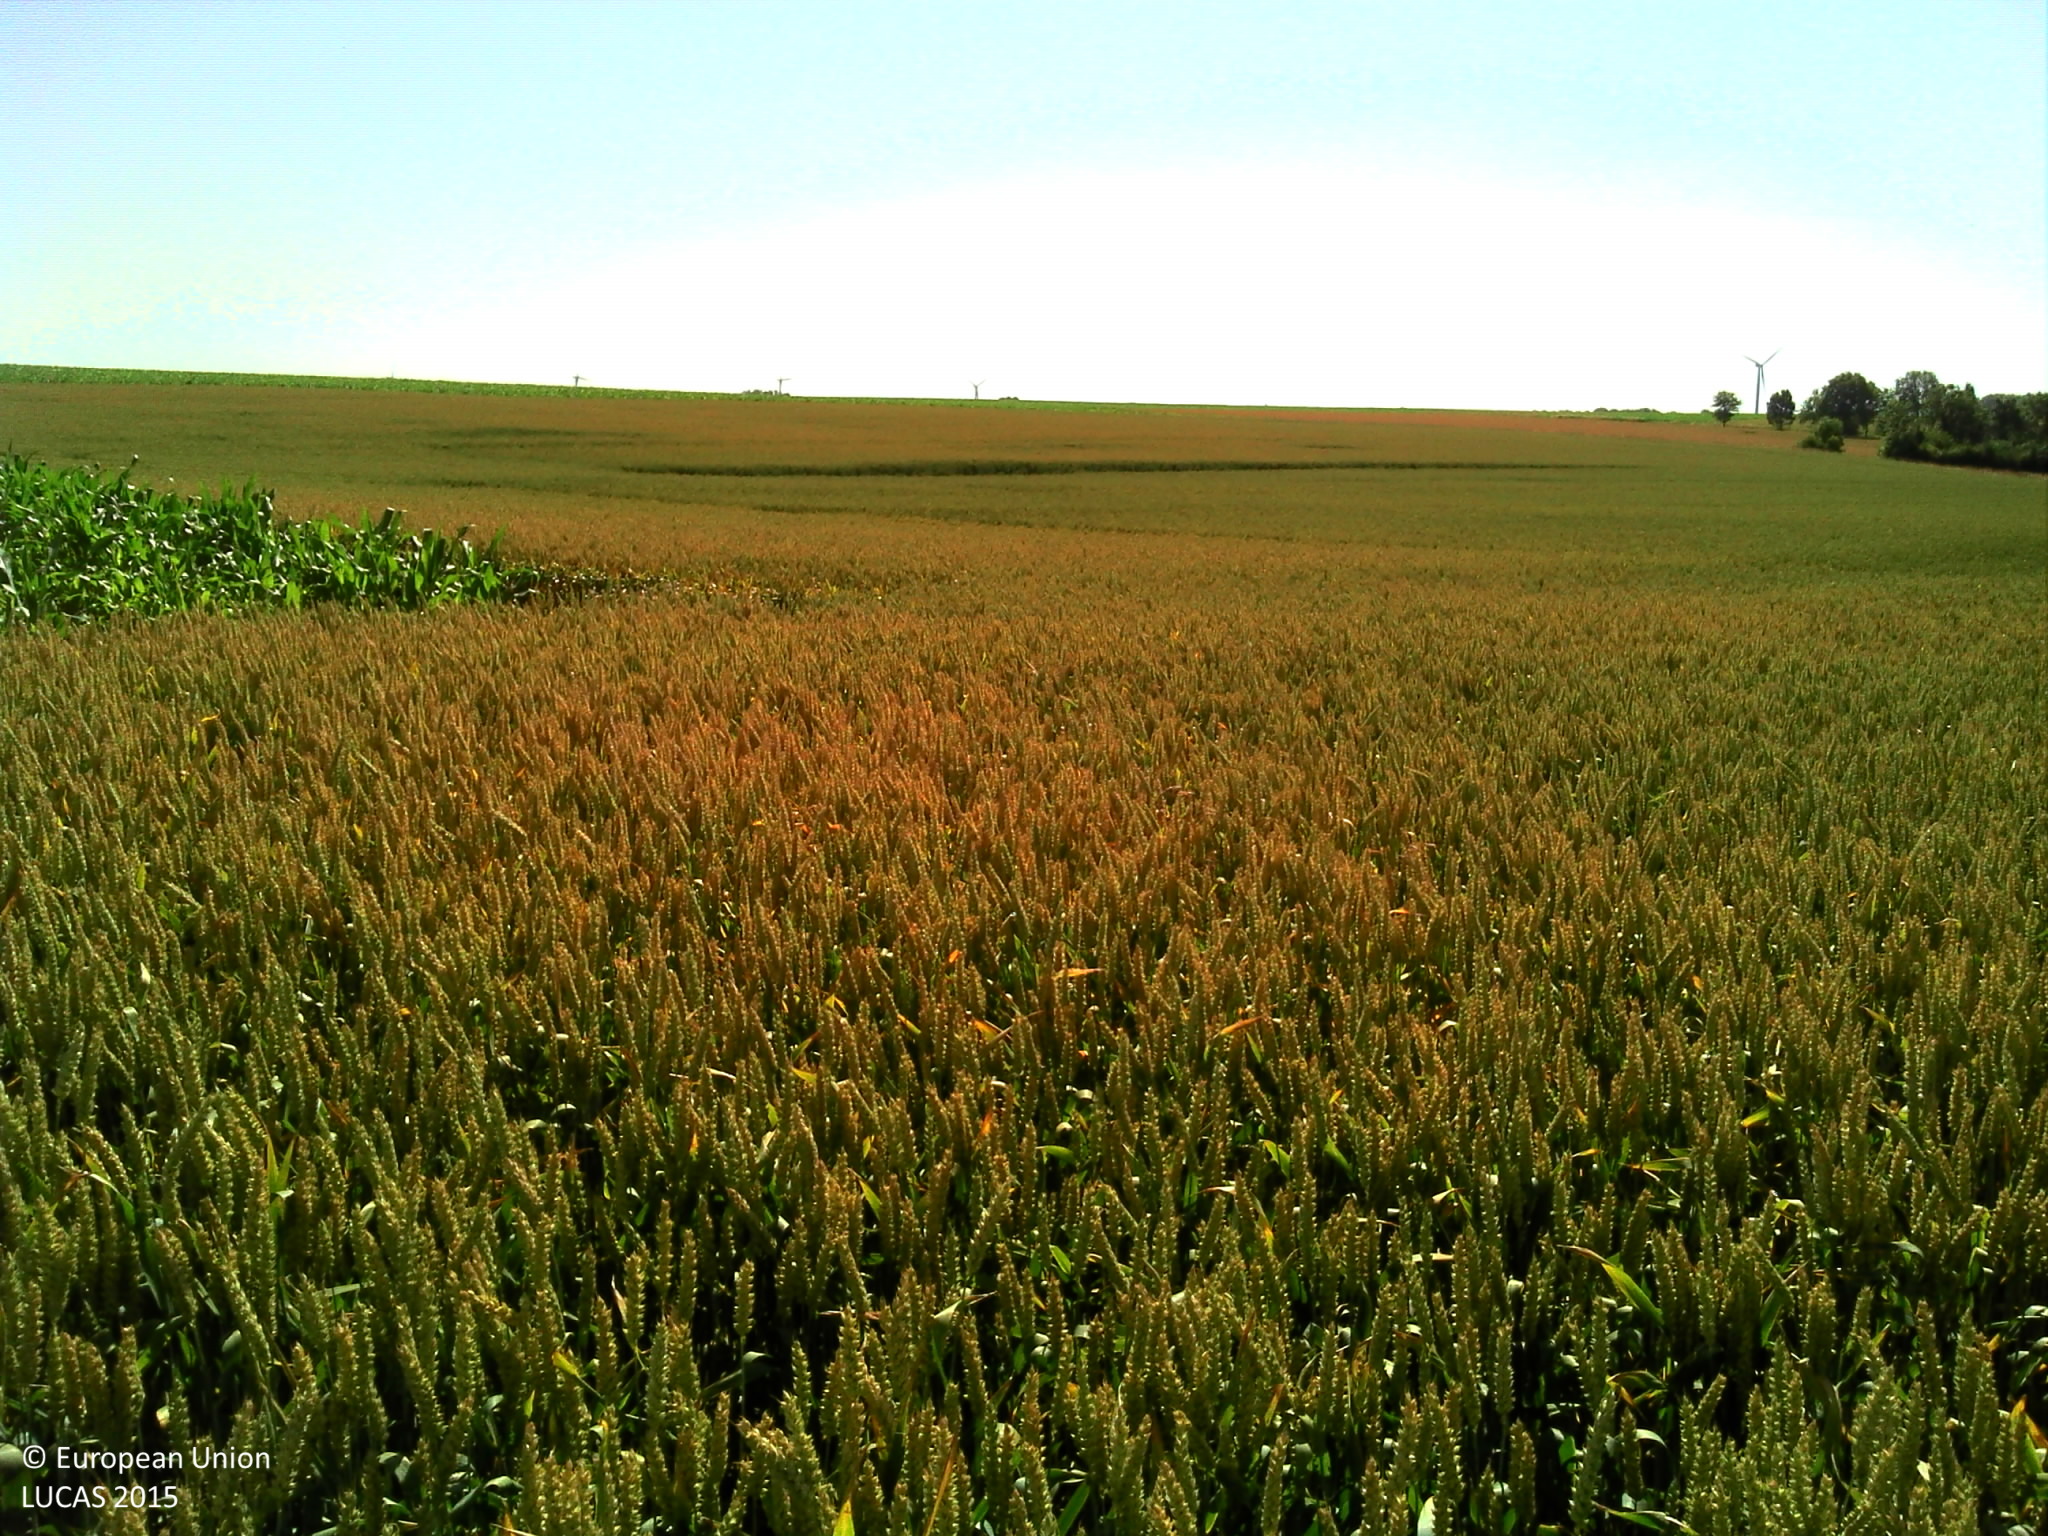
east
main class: Cropland
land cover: Common wheat
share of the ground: > 75 %
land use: Agriculture (excluding fallow land and kitchen gardens)
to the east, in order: Common wheat; Maize
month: July
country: FR
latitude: 50.2601
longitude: 2.2006
